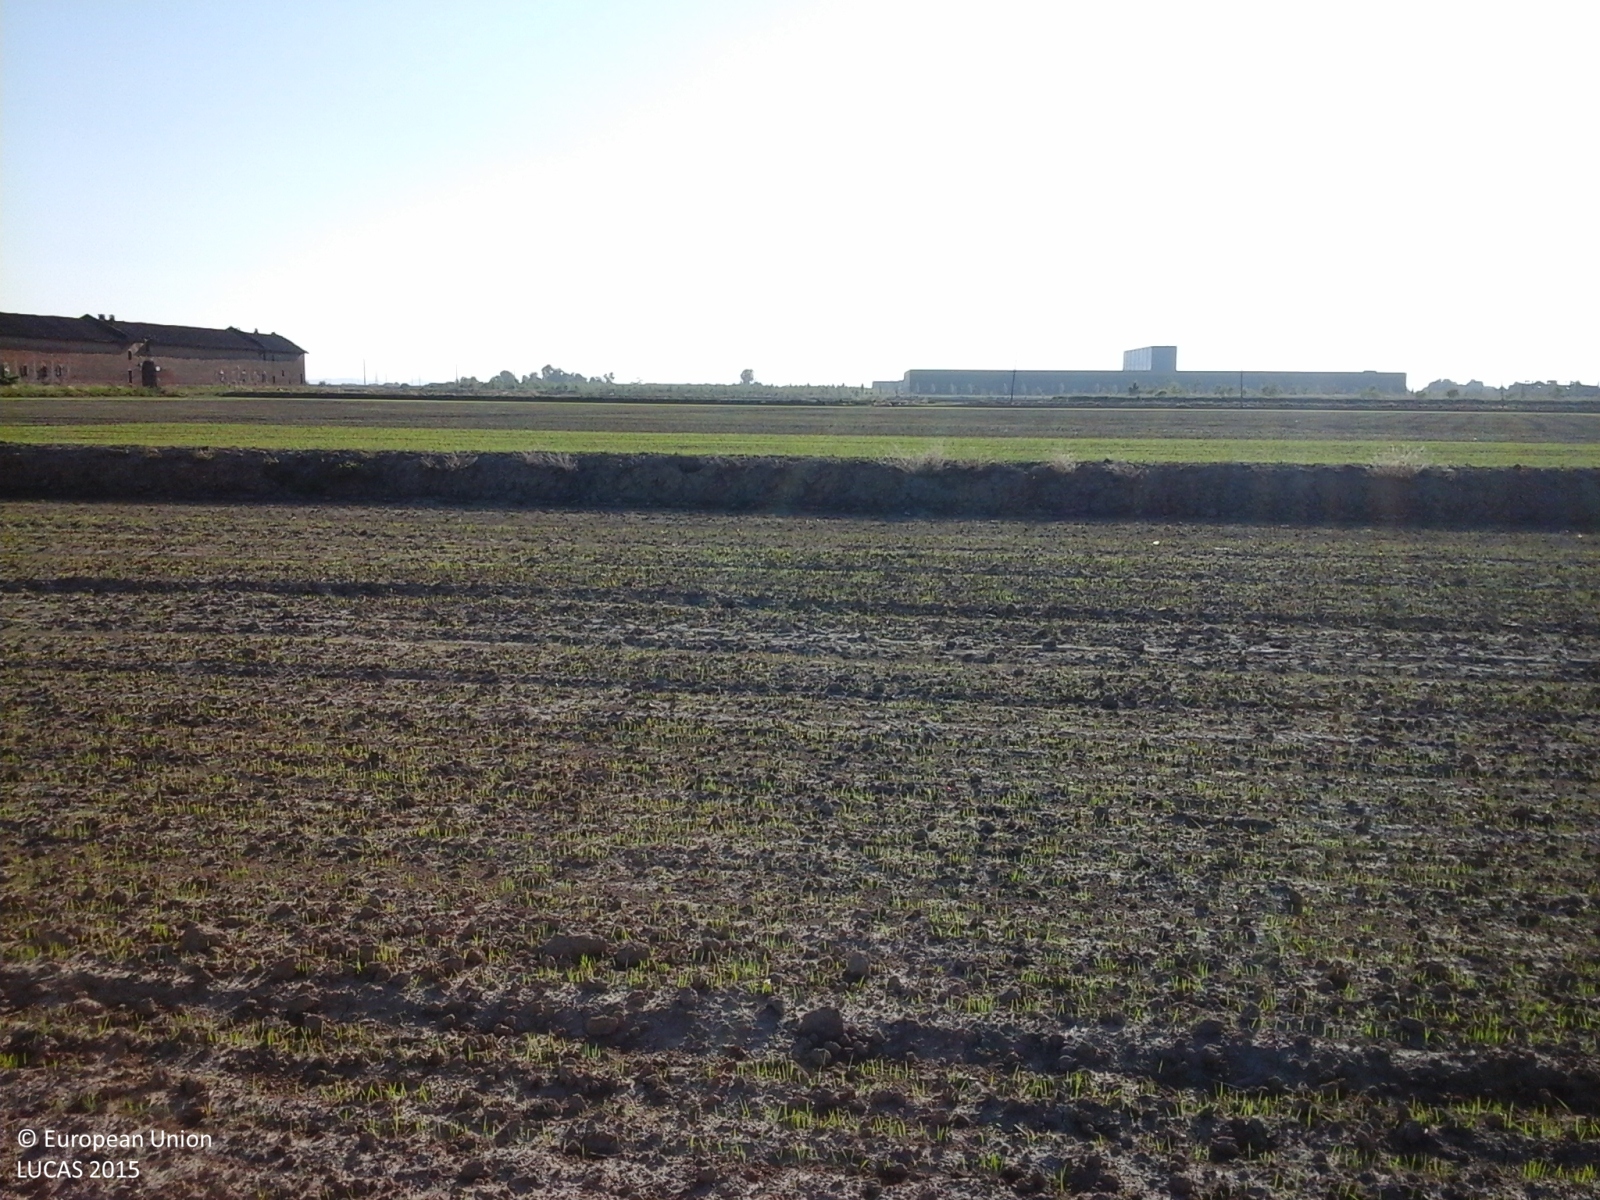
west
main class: Cropland
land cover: Rice
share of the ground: < 10 %
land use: Agriculture (excluding fallow land and kitchen gardens)
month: May
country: IT
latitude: 45.2941
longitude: 8.4089
